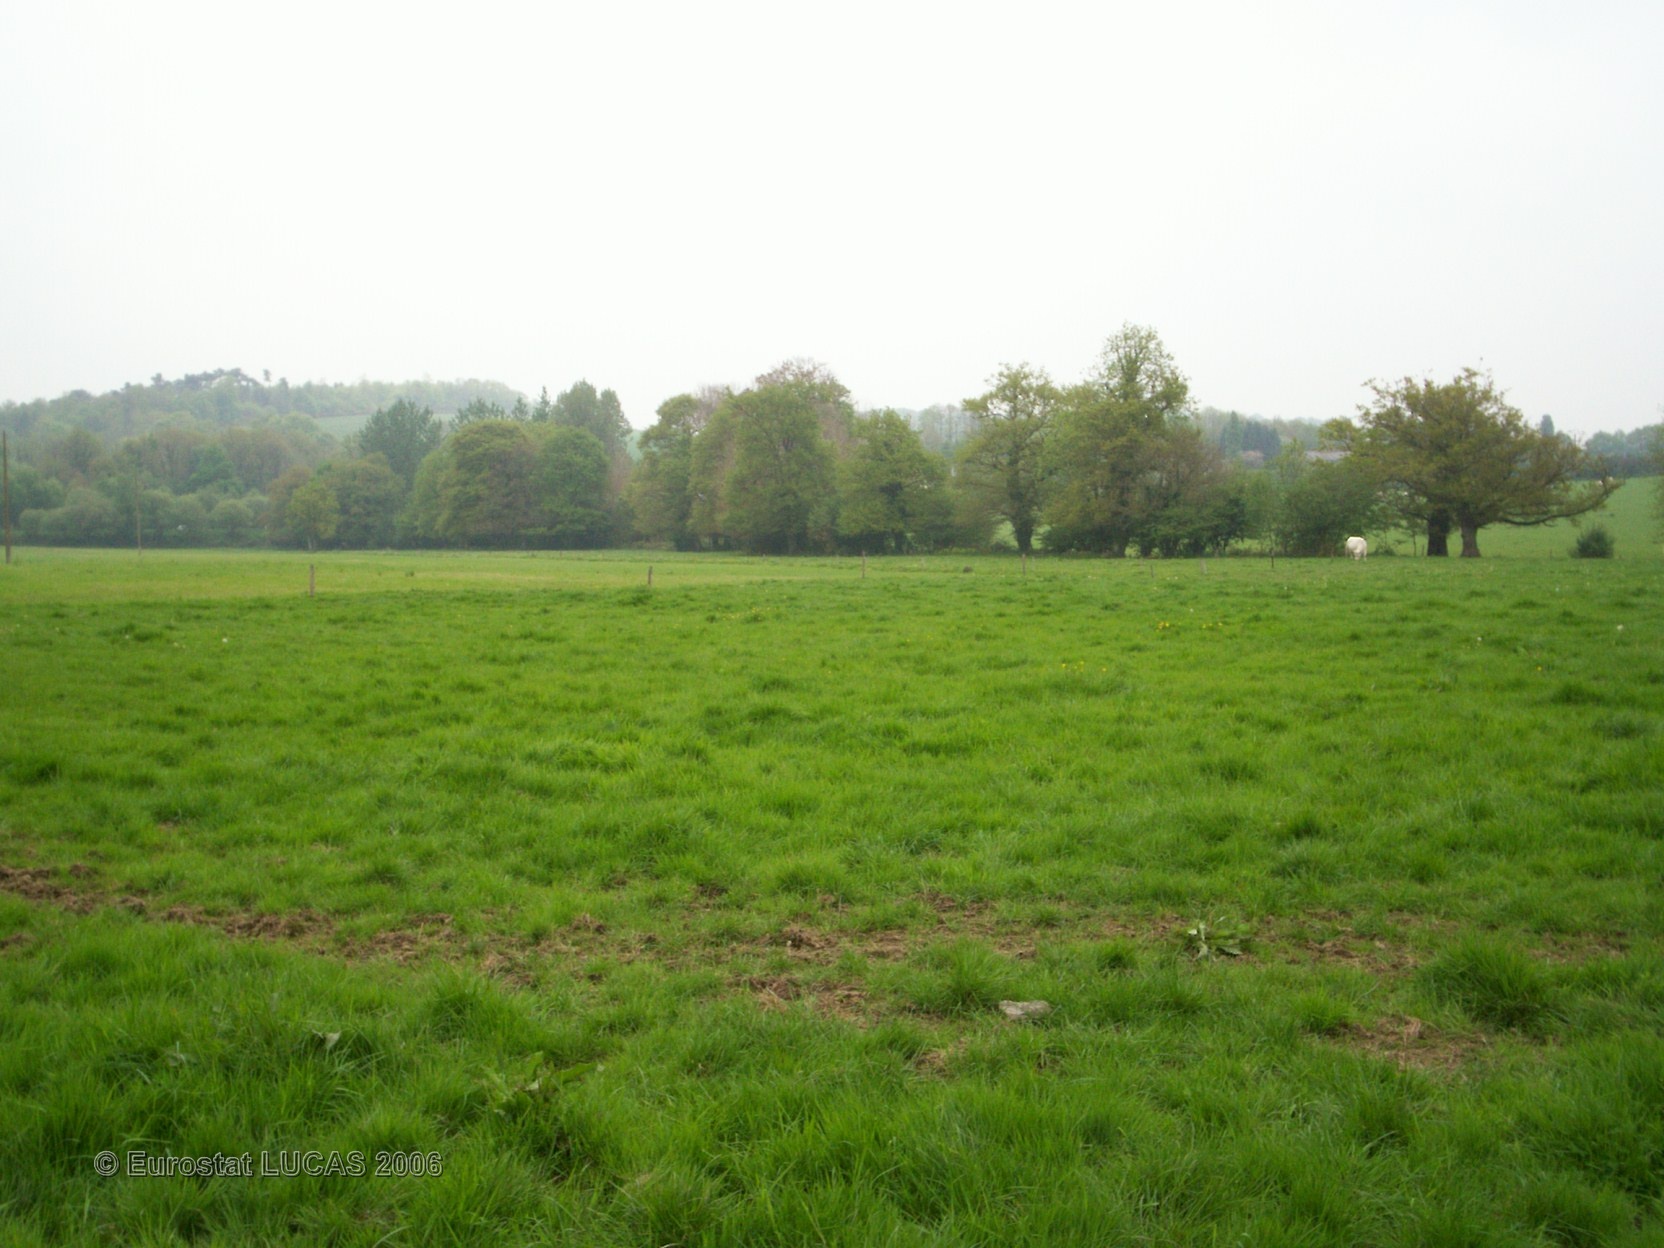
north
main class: Grassland
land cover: Grassland without tree/shrub cover
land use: Agriculture (excluding fallow land and kitchen gardens)
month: May
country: FR
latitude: 48.2004
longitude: -2.9712
